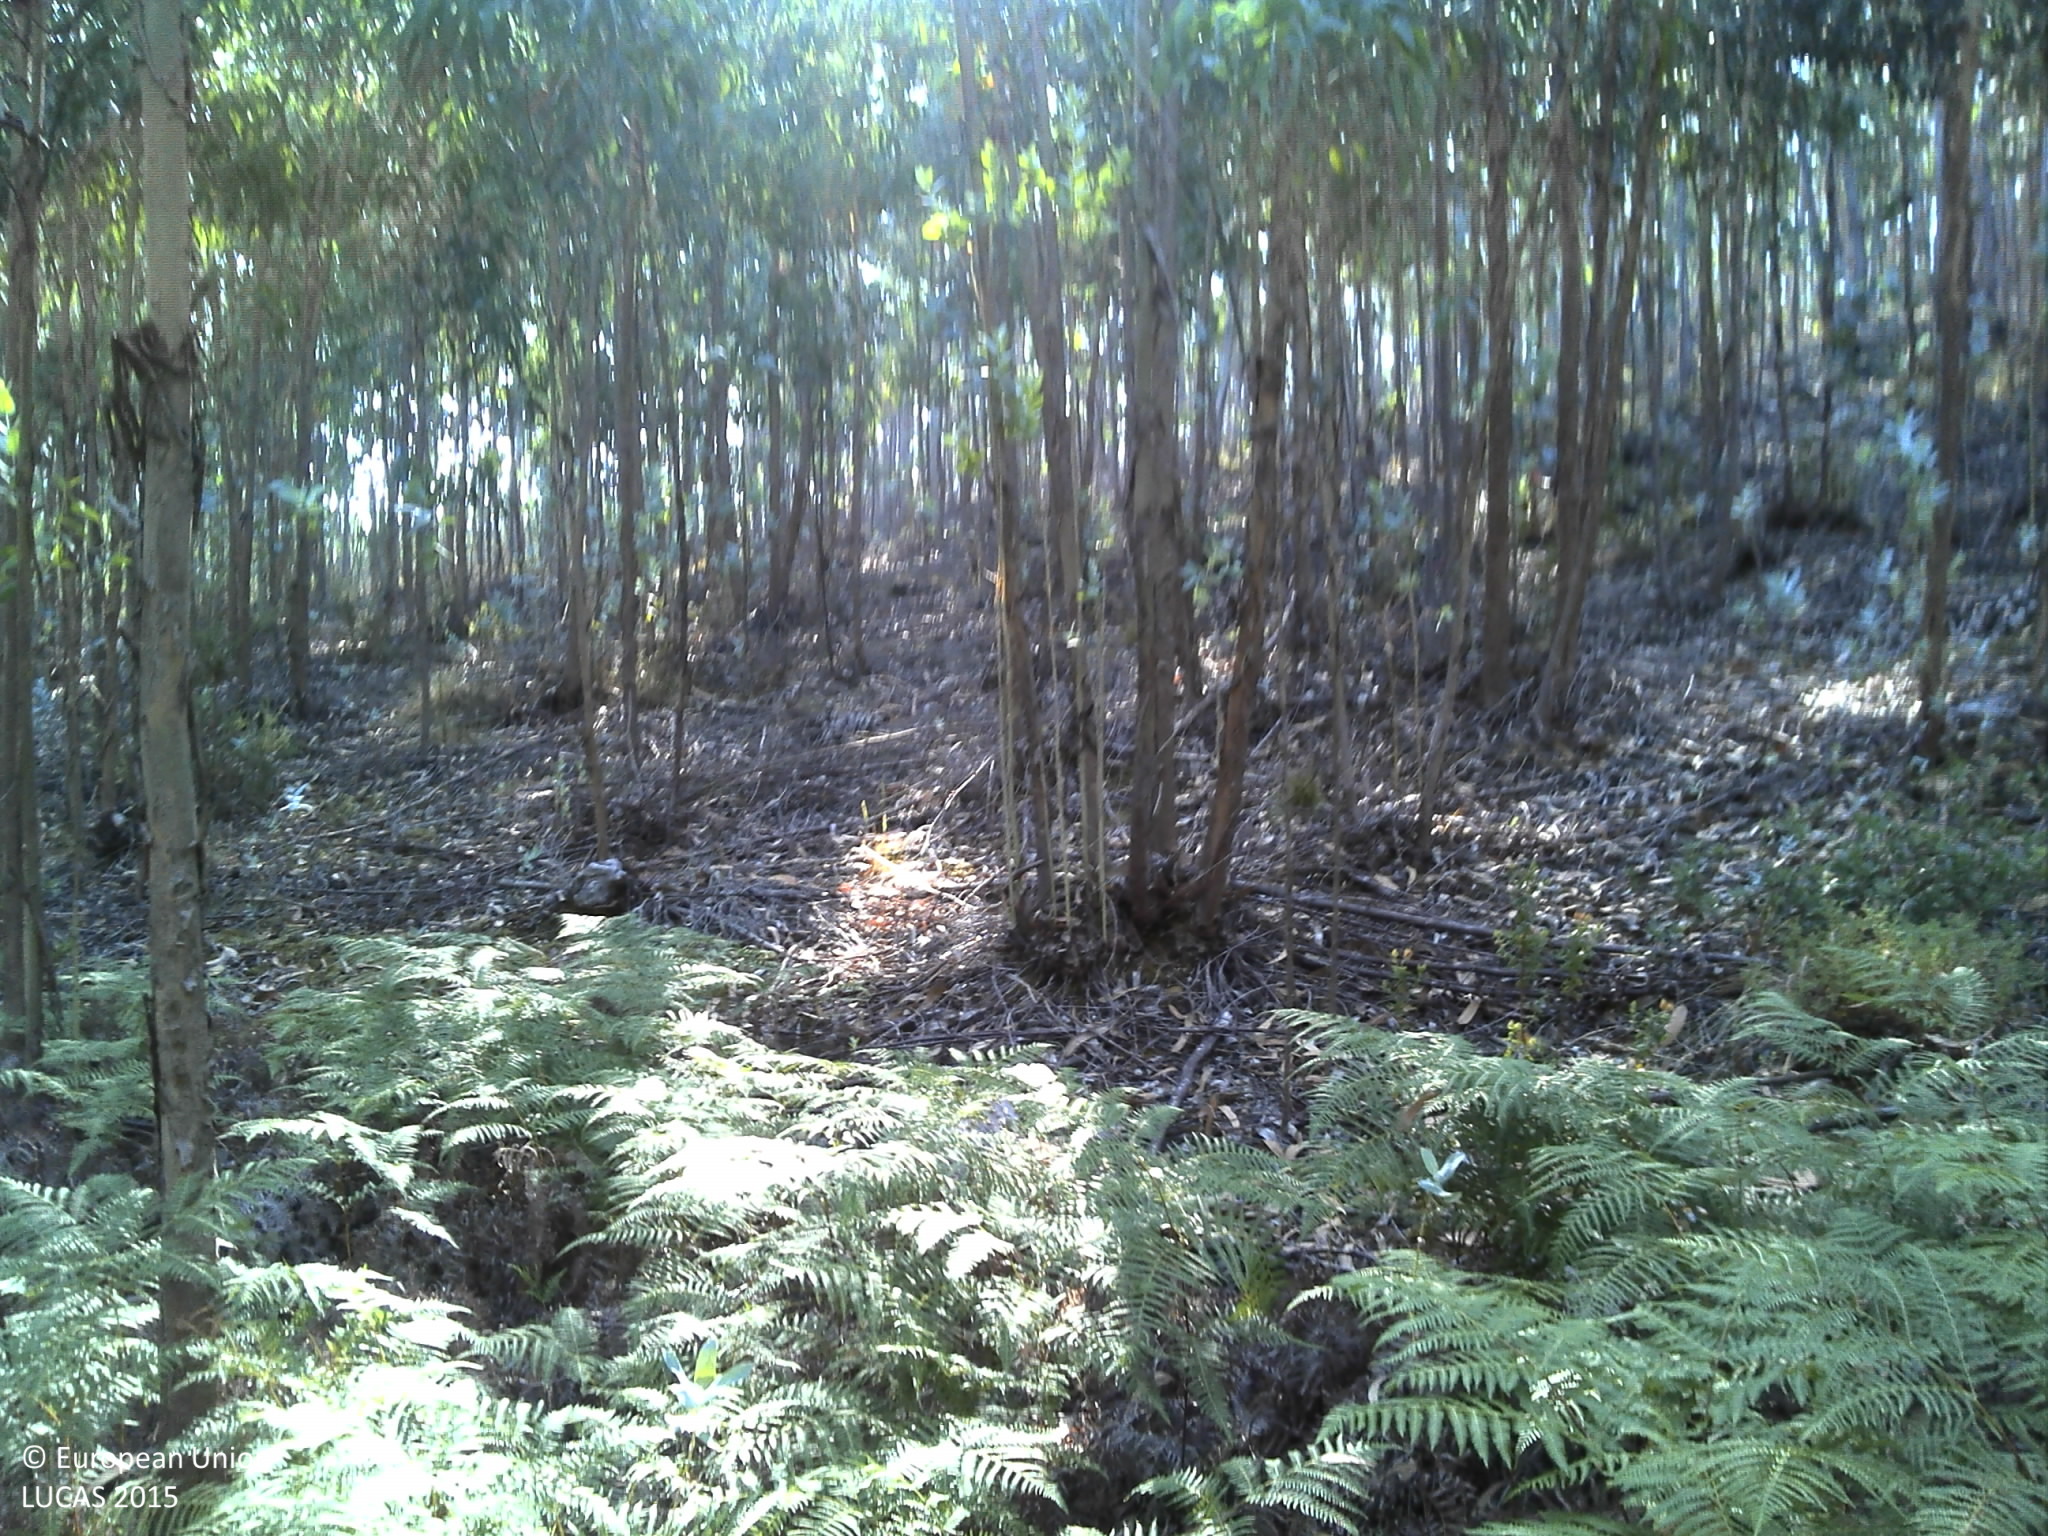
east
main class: Woodland
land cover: Broadleaved woodland
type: exotic forest
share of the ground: > 75 %
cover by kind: broadleaved forest trees 75 %, unconsolidated bare surface 20 %, shrubs 5 %
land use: Forestry
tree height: > 5 m
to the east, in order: Broadleaved woodland; Tracks; Broadleaved woodland
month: June
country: PT
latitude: 39.1188
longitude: -9.2516
